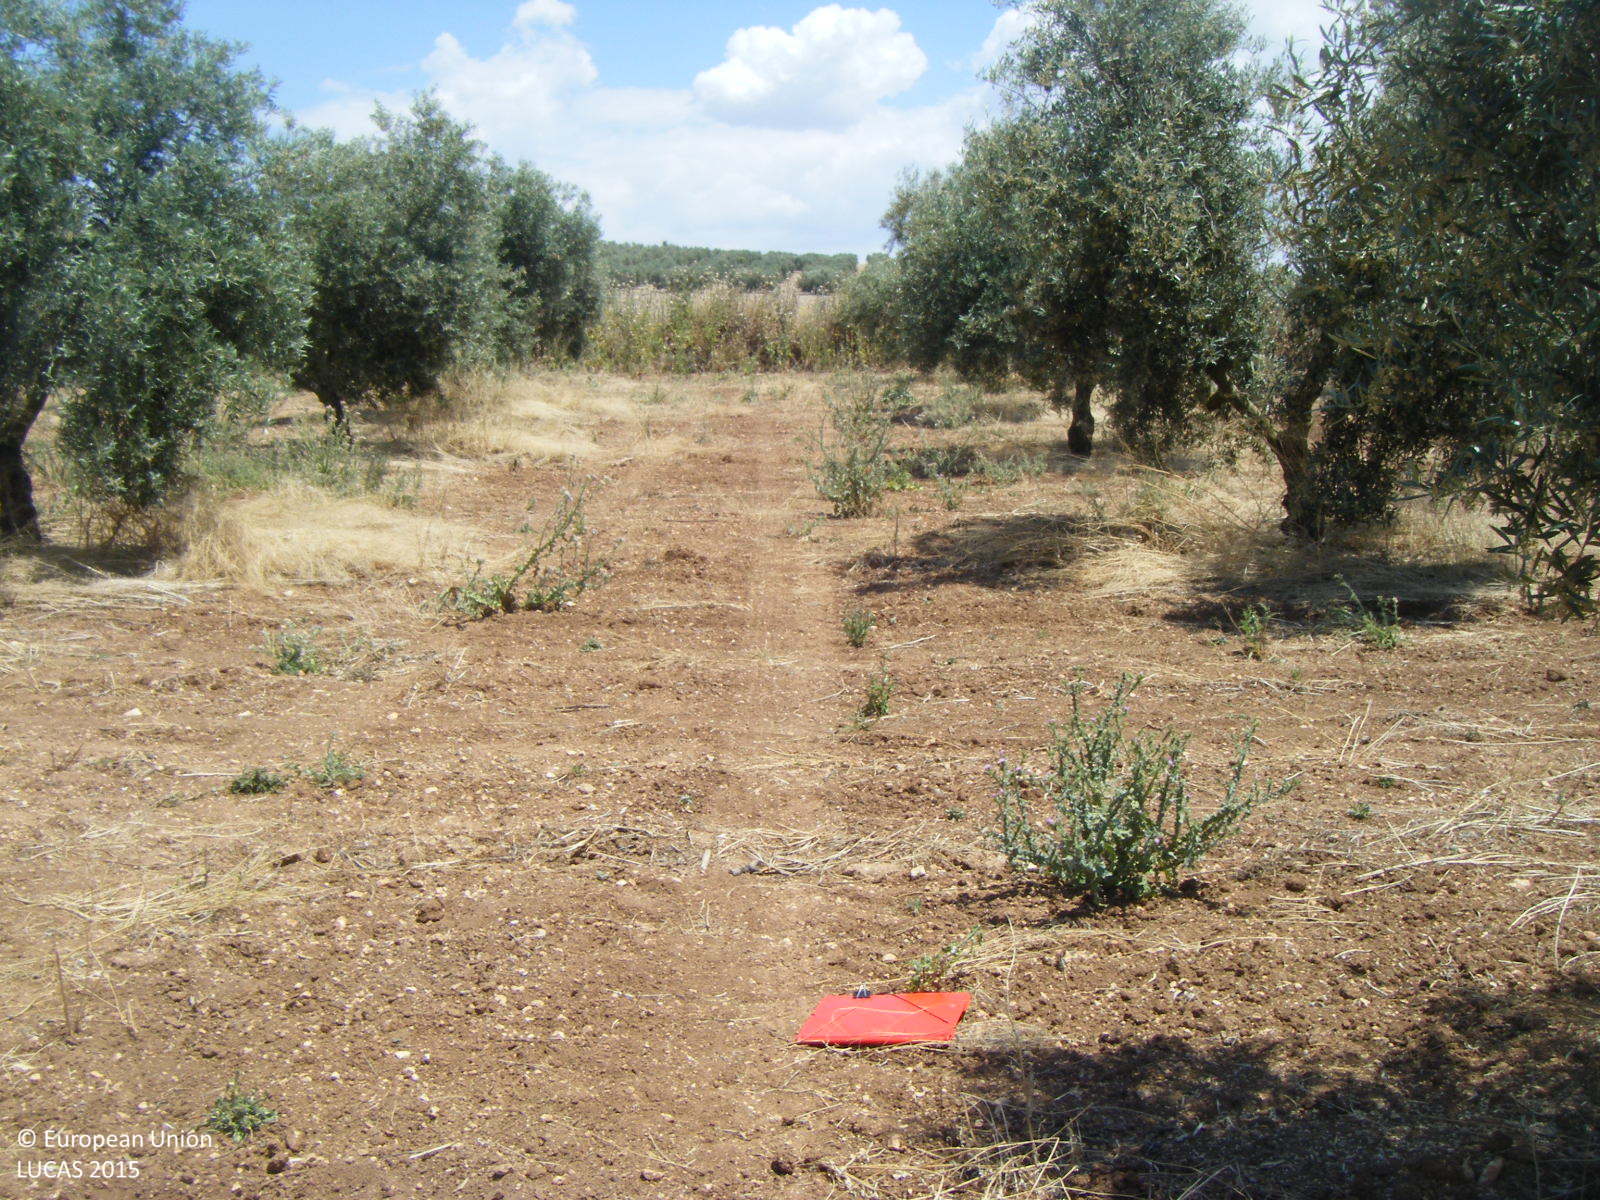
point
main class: Cropland
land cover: Olive groves
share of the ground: 10 - 25 %
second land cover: Other bare soil
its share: > 75 %
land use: Agriculture (excluding fallow land and kitchen gardens)
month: May
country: ES
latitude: 37.1788
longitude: -4.5176
